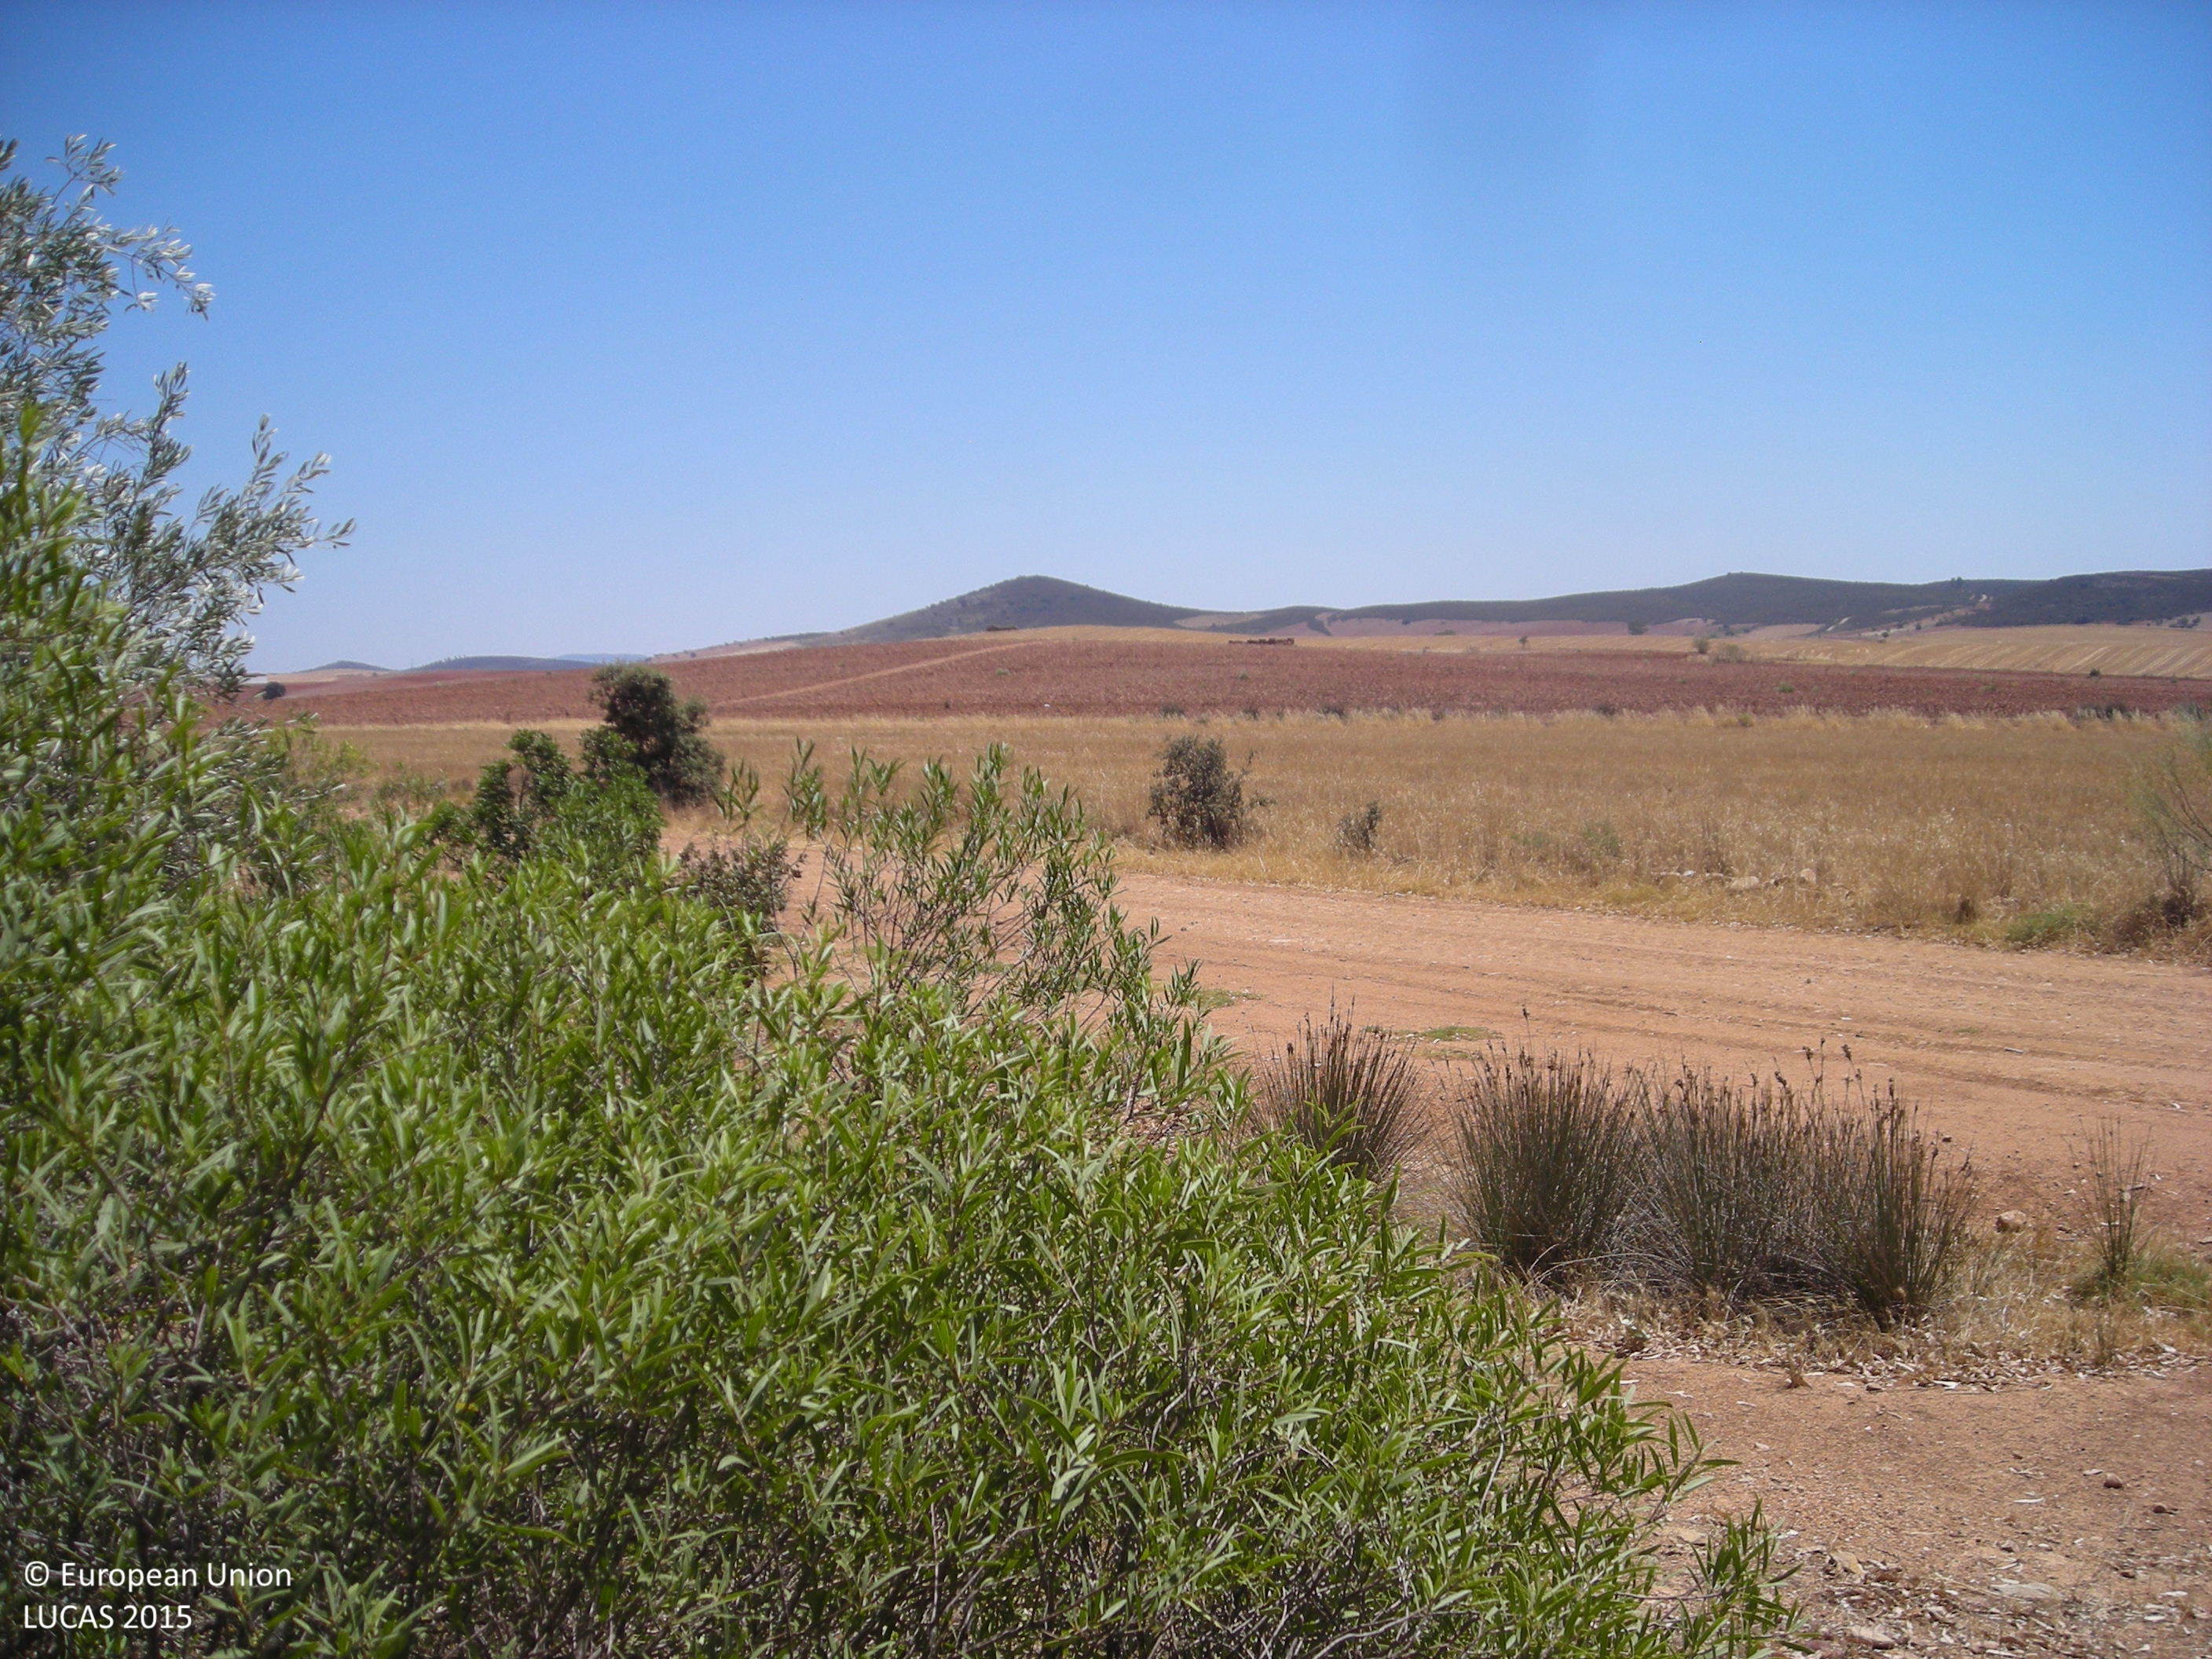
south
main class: Shrubland
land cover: Shrubland without tree cover
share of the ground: > 75 %
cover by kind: shrubs 100 %
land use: Semi-natural and natural areas not in use
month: July
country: ES
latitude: 38.7574
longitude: -5.7986
